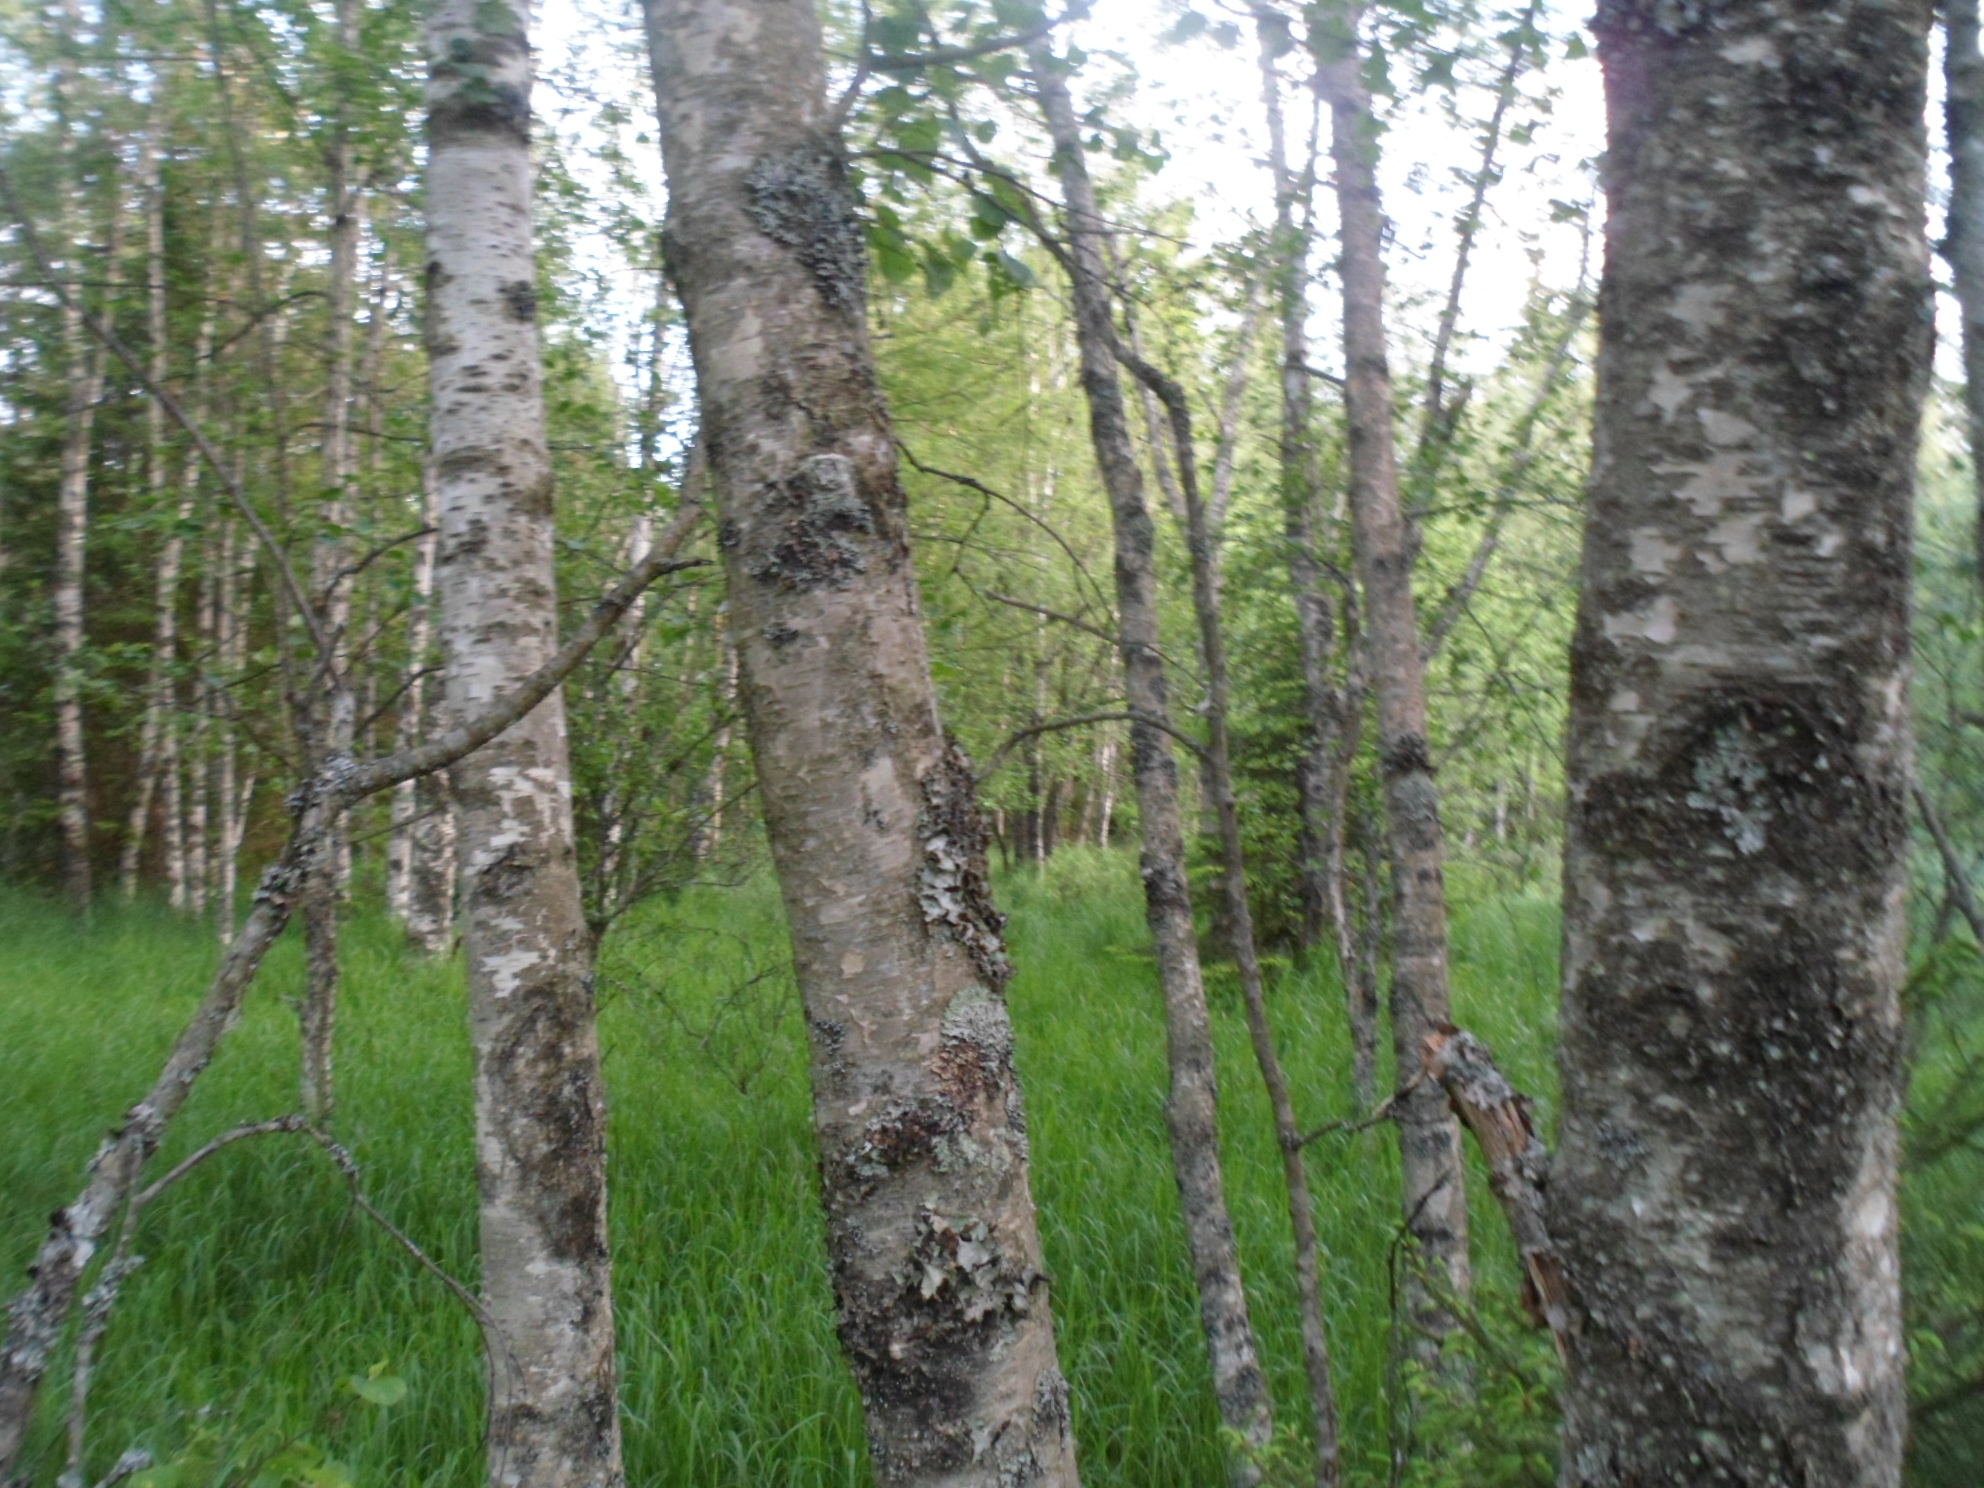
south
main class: Woodland
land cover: Broadleaved woodland
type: mire and swamp forests
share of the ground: 50 - 75 %
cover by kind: broadleaved forest trees 60 %, herbaceous plants 25 %, lichens and mosses 10 %, shrubs 5 %
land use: Forestry
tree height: > 5 m
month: June
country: SE
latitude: 57.1044
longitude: 15.3298
